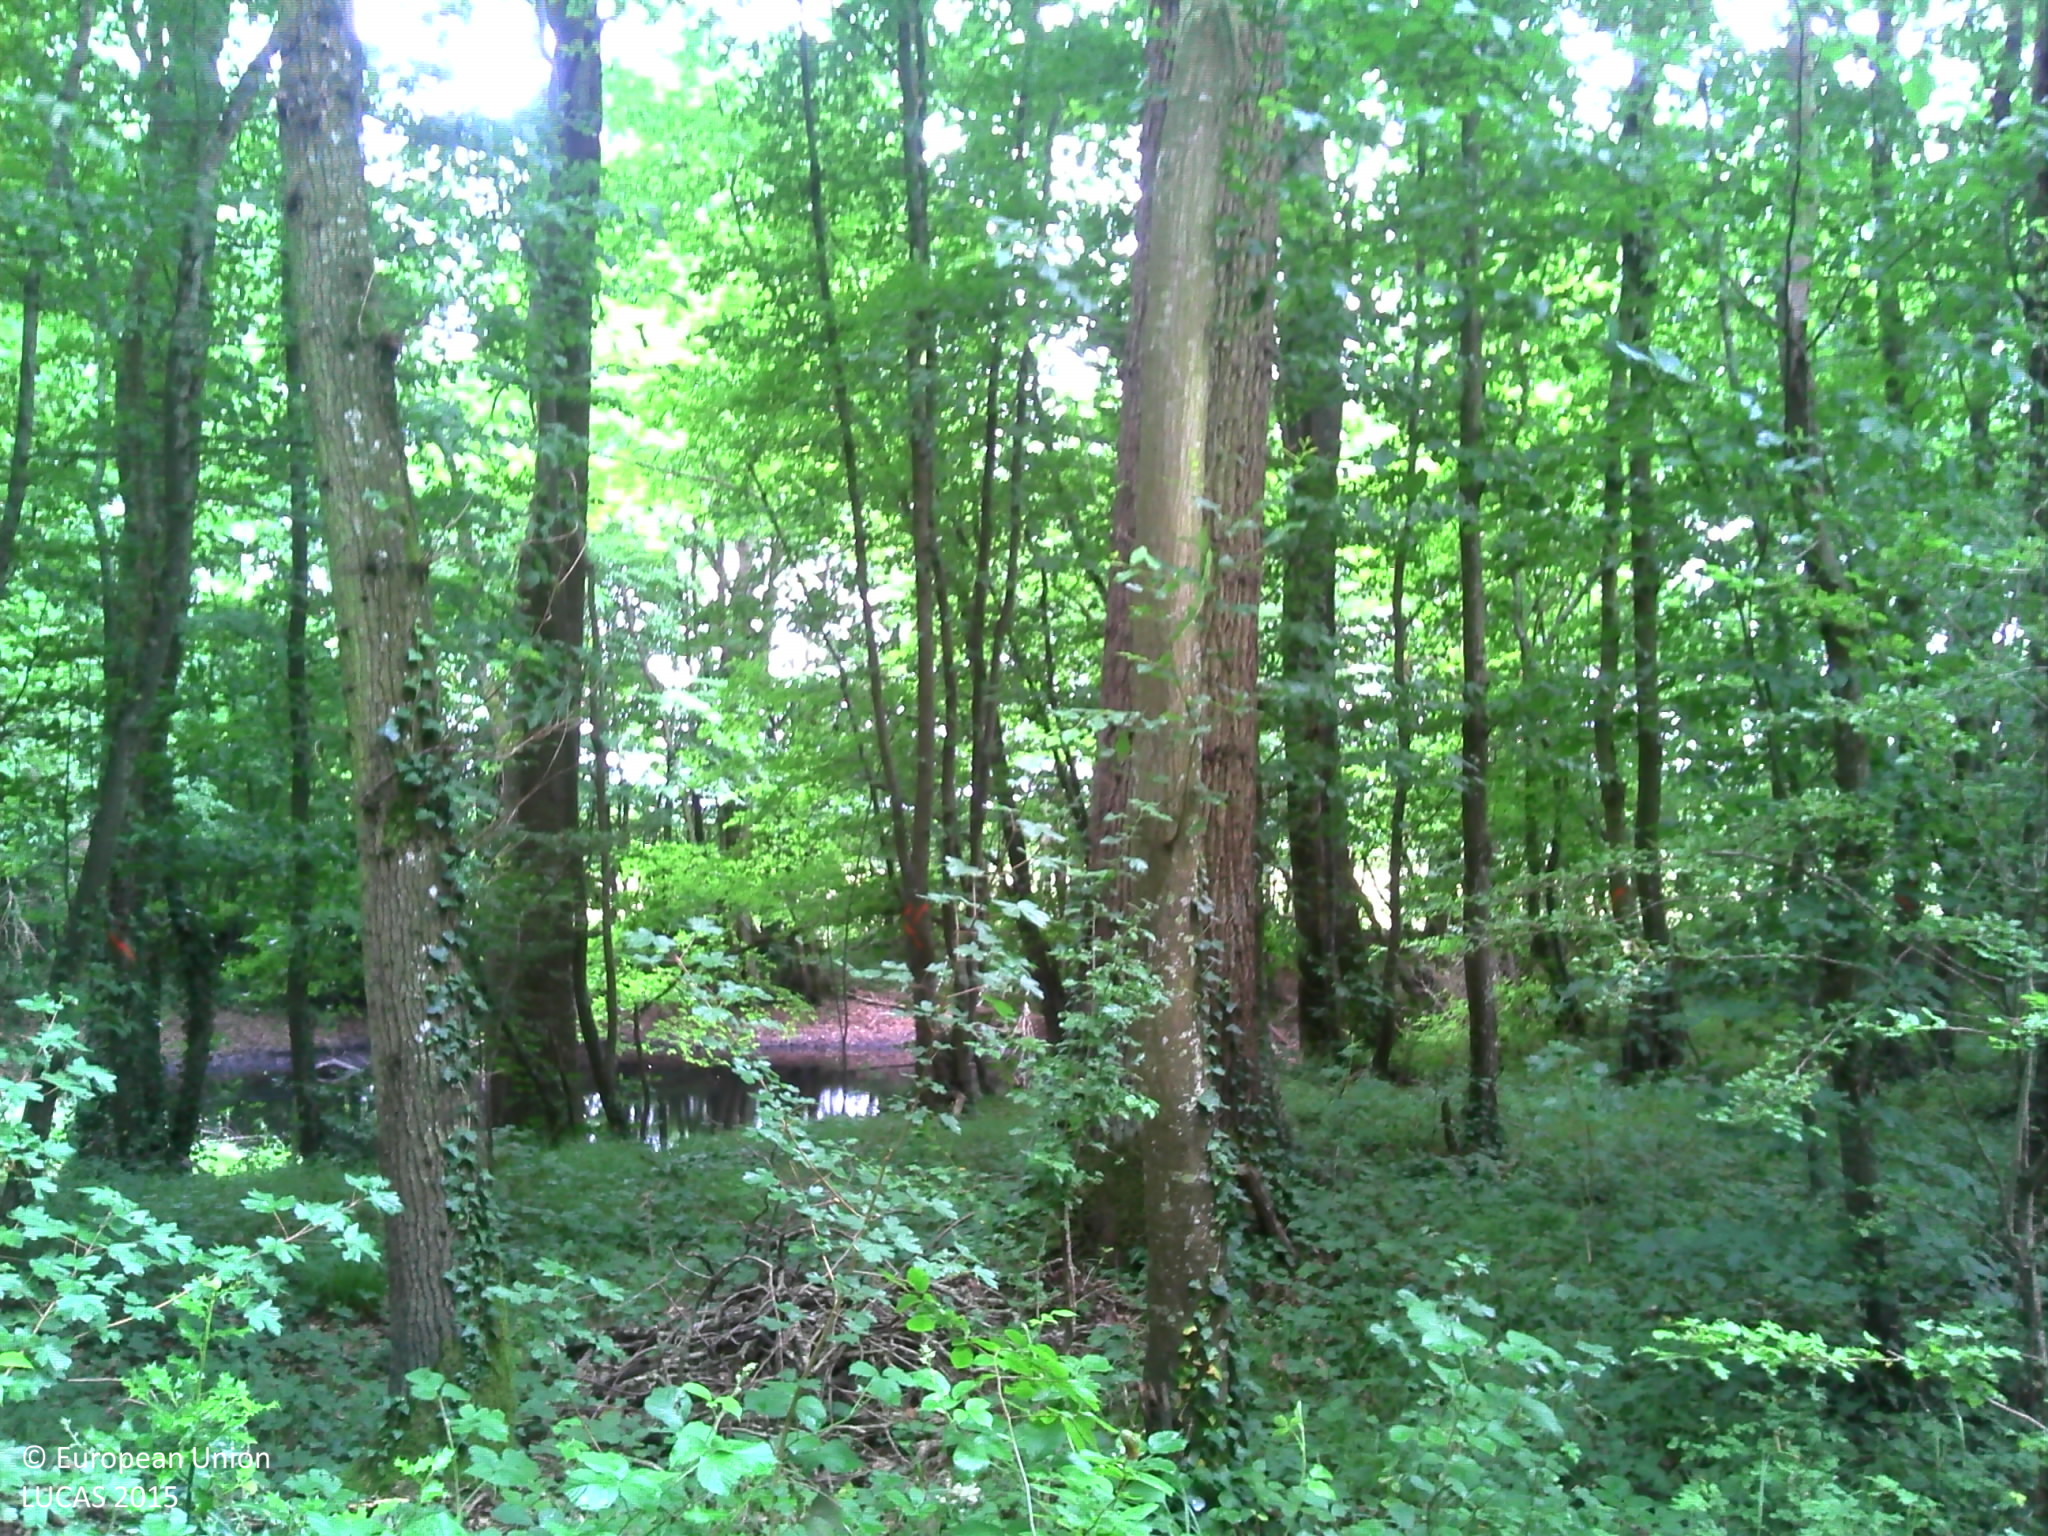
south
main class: Woodland
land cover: Broadleaved woodland
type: beech forest
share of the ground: > 75 %
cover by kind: broadleaved forest trees 65 %, herbaceous plants 20 %, shrubs 15 %
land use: Forestry
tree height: > 5 m
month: June
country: FR
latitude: 48.1177
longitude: 0.2620
